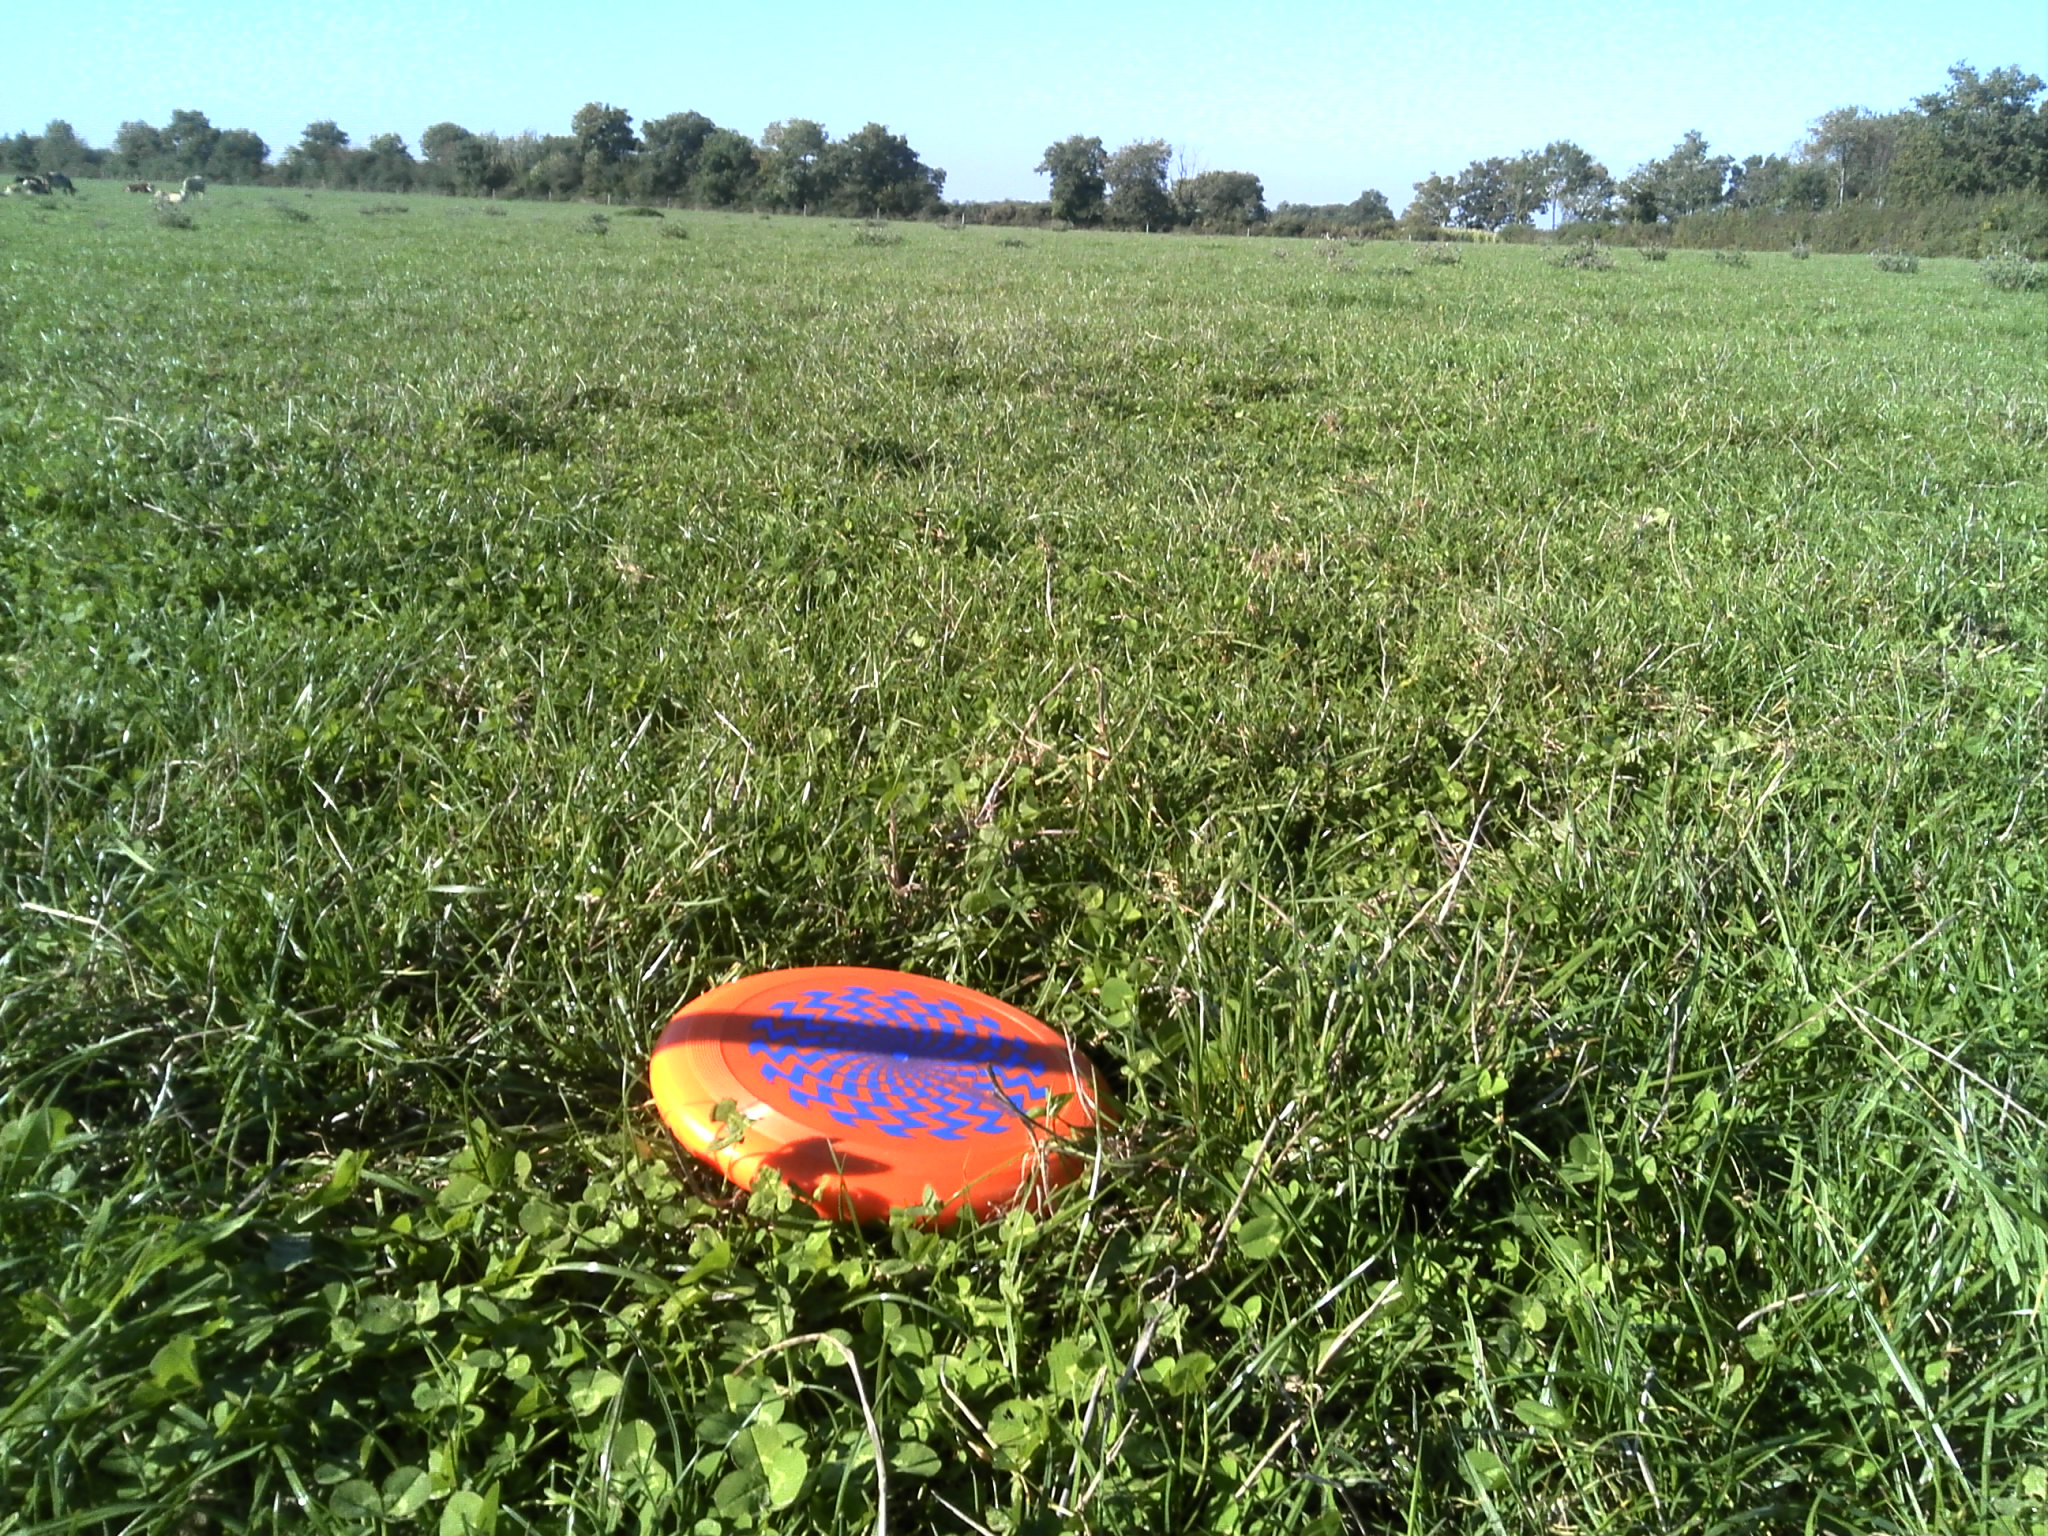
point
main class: Grassland
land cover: Grassland without tree/shrub cover
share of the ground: > 75 %
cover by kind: herbaceous plants 100 %
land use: Agriculture (excluding fallow land and kitchen gardens)
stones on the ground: < 10 %
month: October
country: FR
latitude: 47.6128
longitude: -1.0397
